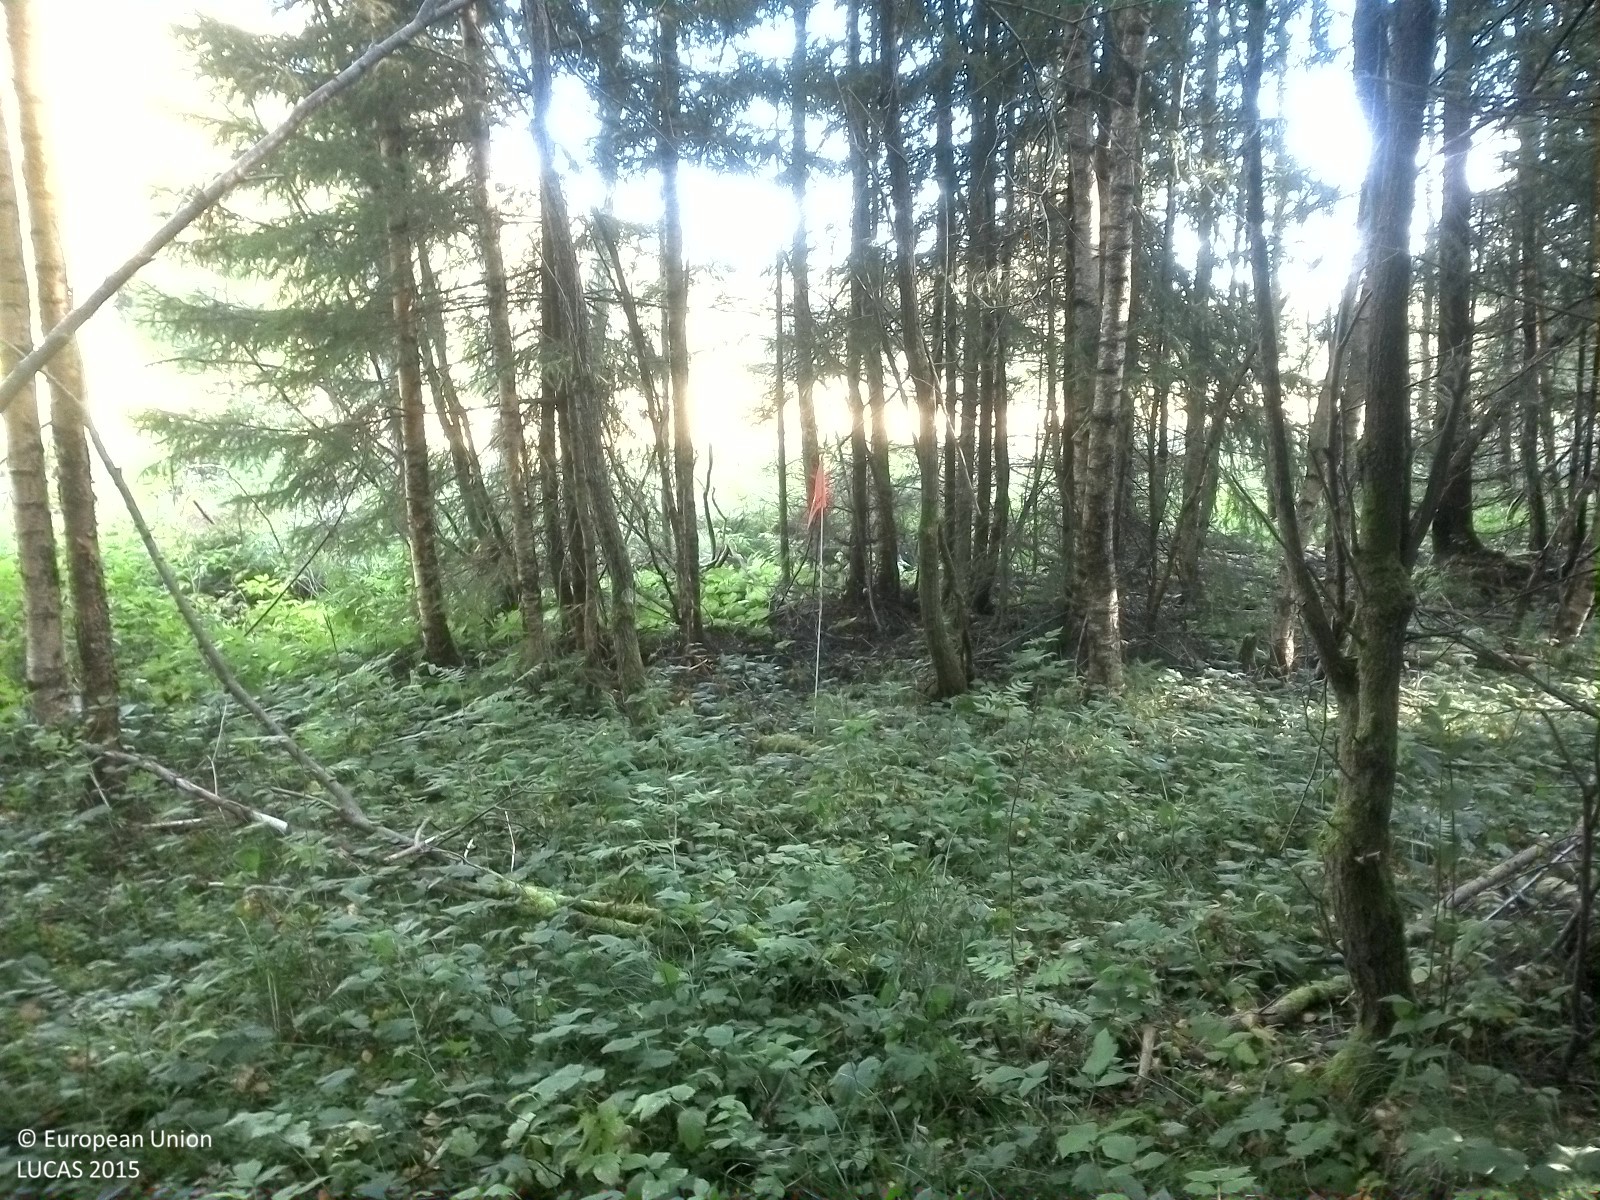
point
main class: Woodland
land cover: Spruce dominated mixed woodland
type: boreal forest
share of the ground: 50 - 75 %
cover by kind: herbaceous plants 35 %, coniferous forest trees 30 %, broadleaved forest trees 20 %, unconsolidated bare surface 10 %, lichens and mosses 5 %
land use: Forestry
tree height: > 5 m
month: September
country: SE
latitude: 58.9732
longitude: 15.0192
